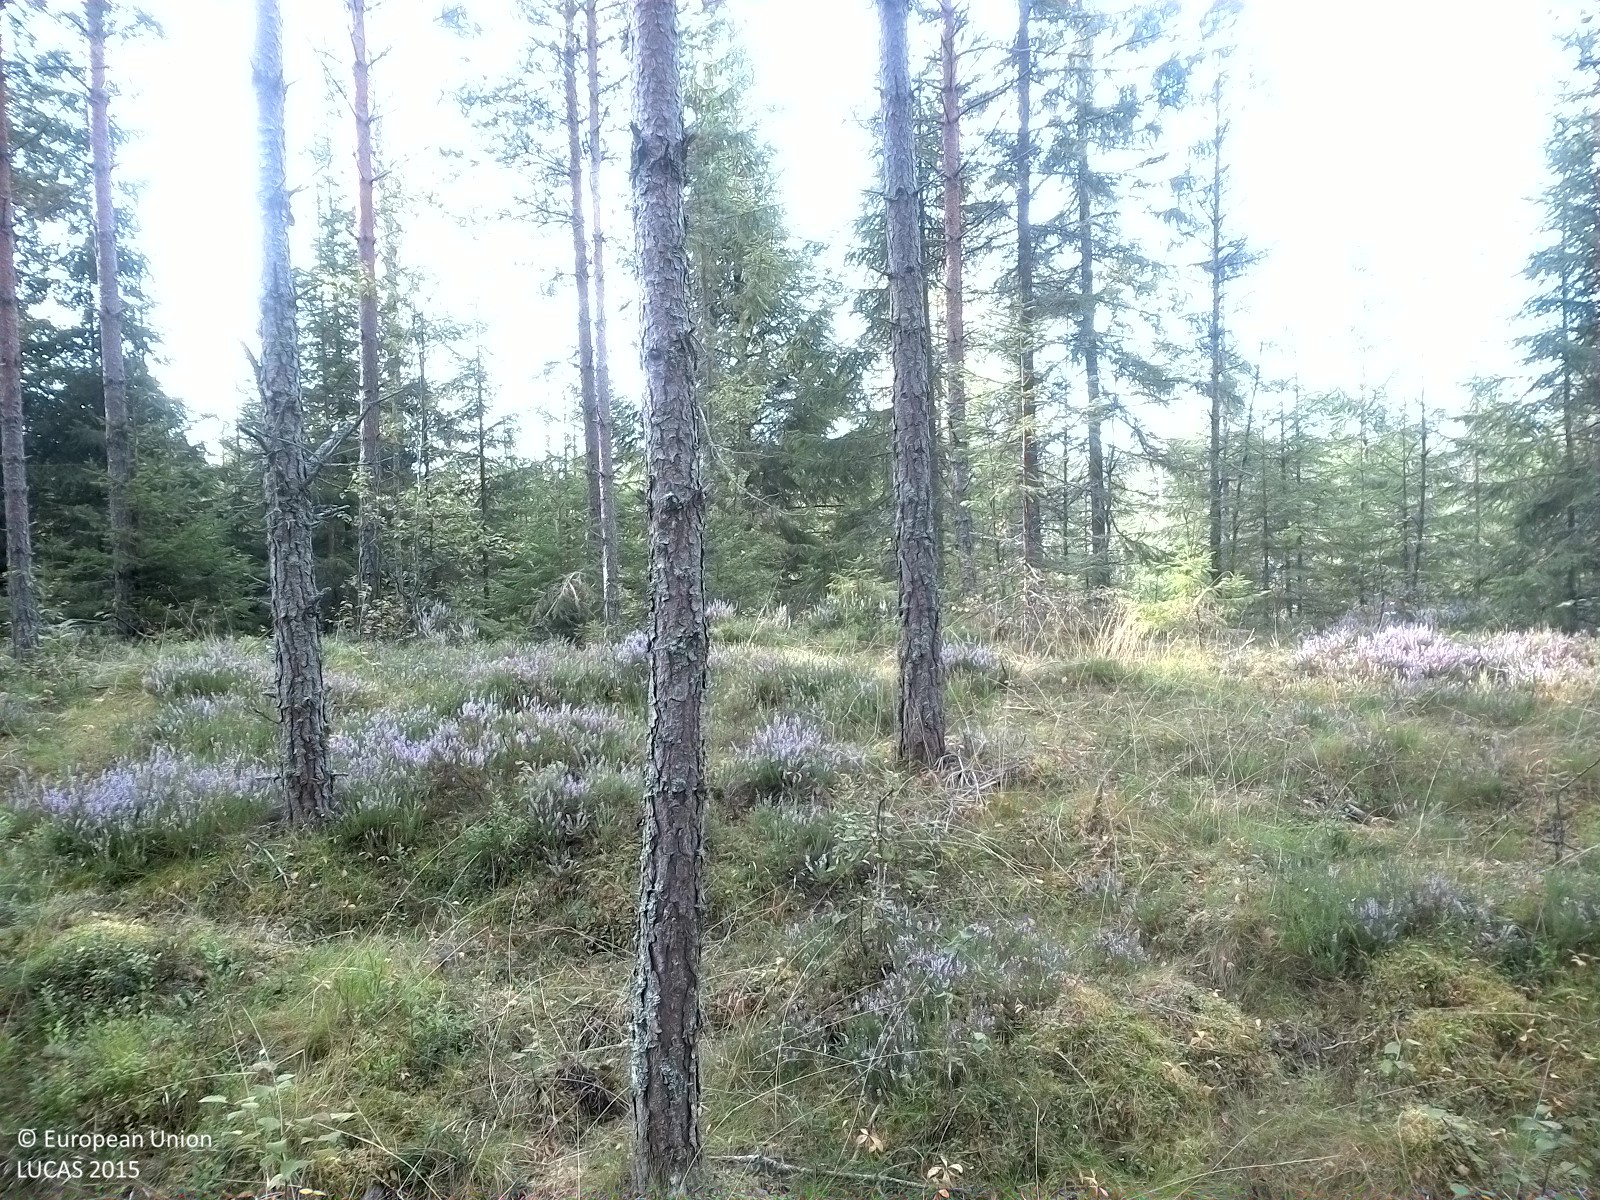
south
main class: Woodland
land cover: Pine dominated coniferous woodland
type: boreal forest
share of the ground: 25 - 50 %
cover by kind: herbaceous plants 35 %, coniferous forest trees 30 %, lichens and mosses 20 %, shrubs 10 %, broadleaved forest trees 5 %
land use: Forestry
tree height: > 5 m
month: August
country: SE
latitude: 58.8291
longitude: 15.4841
